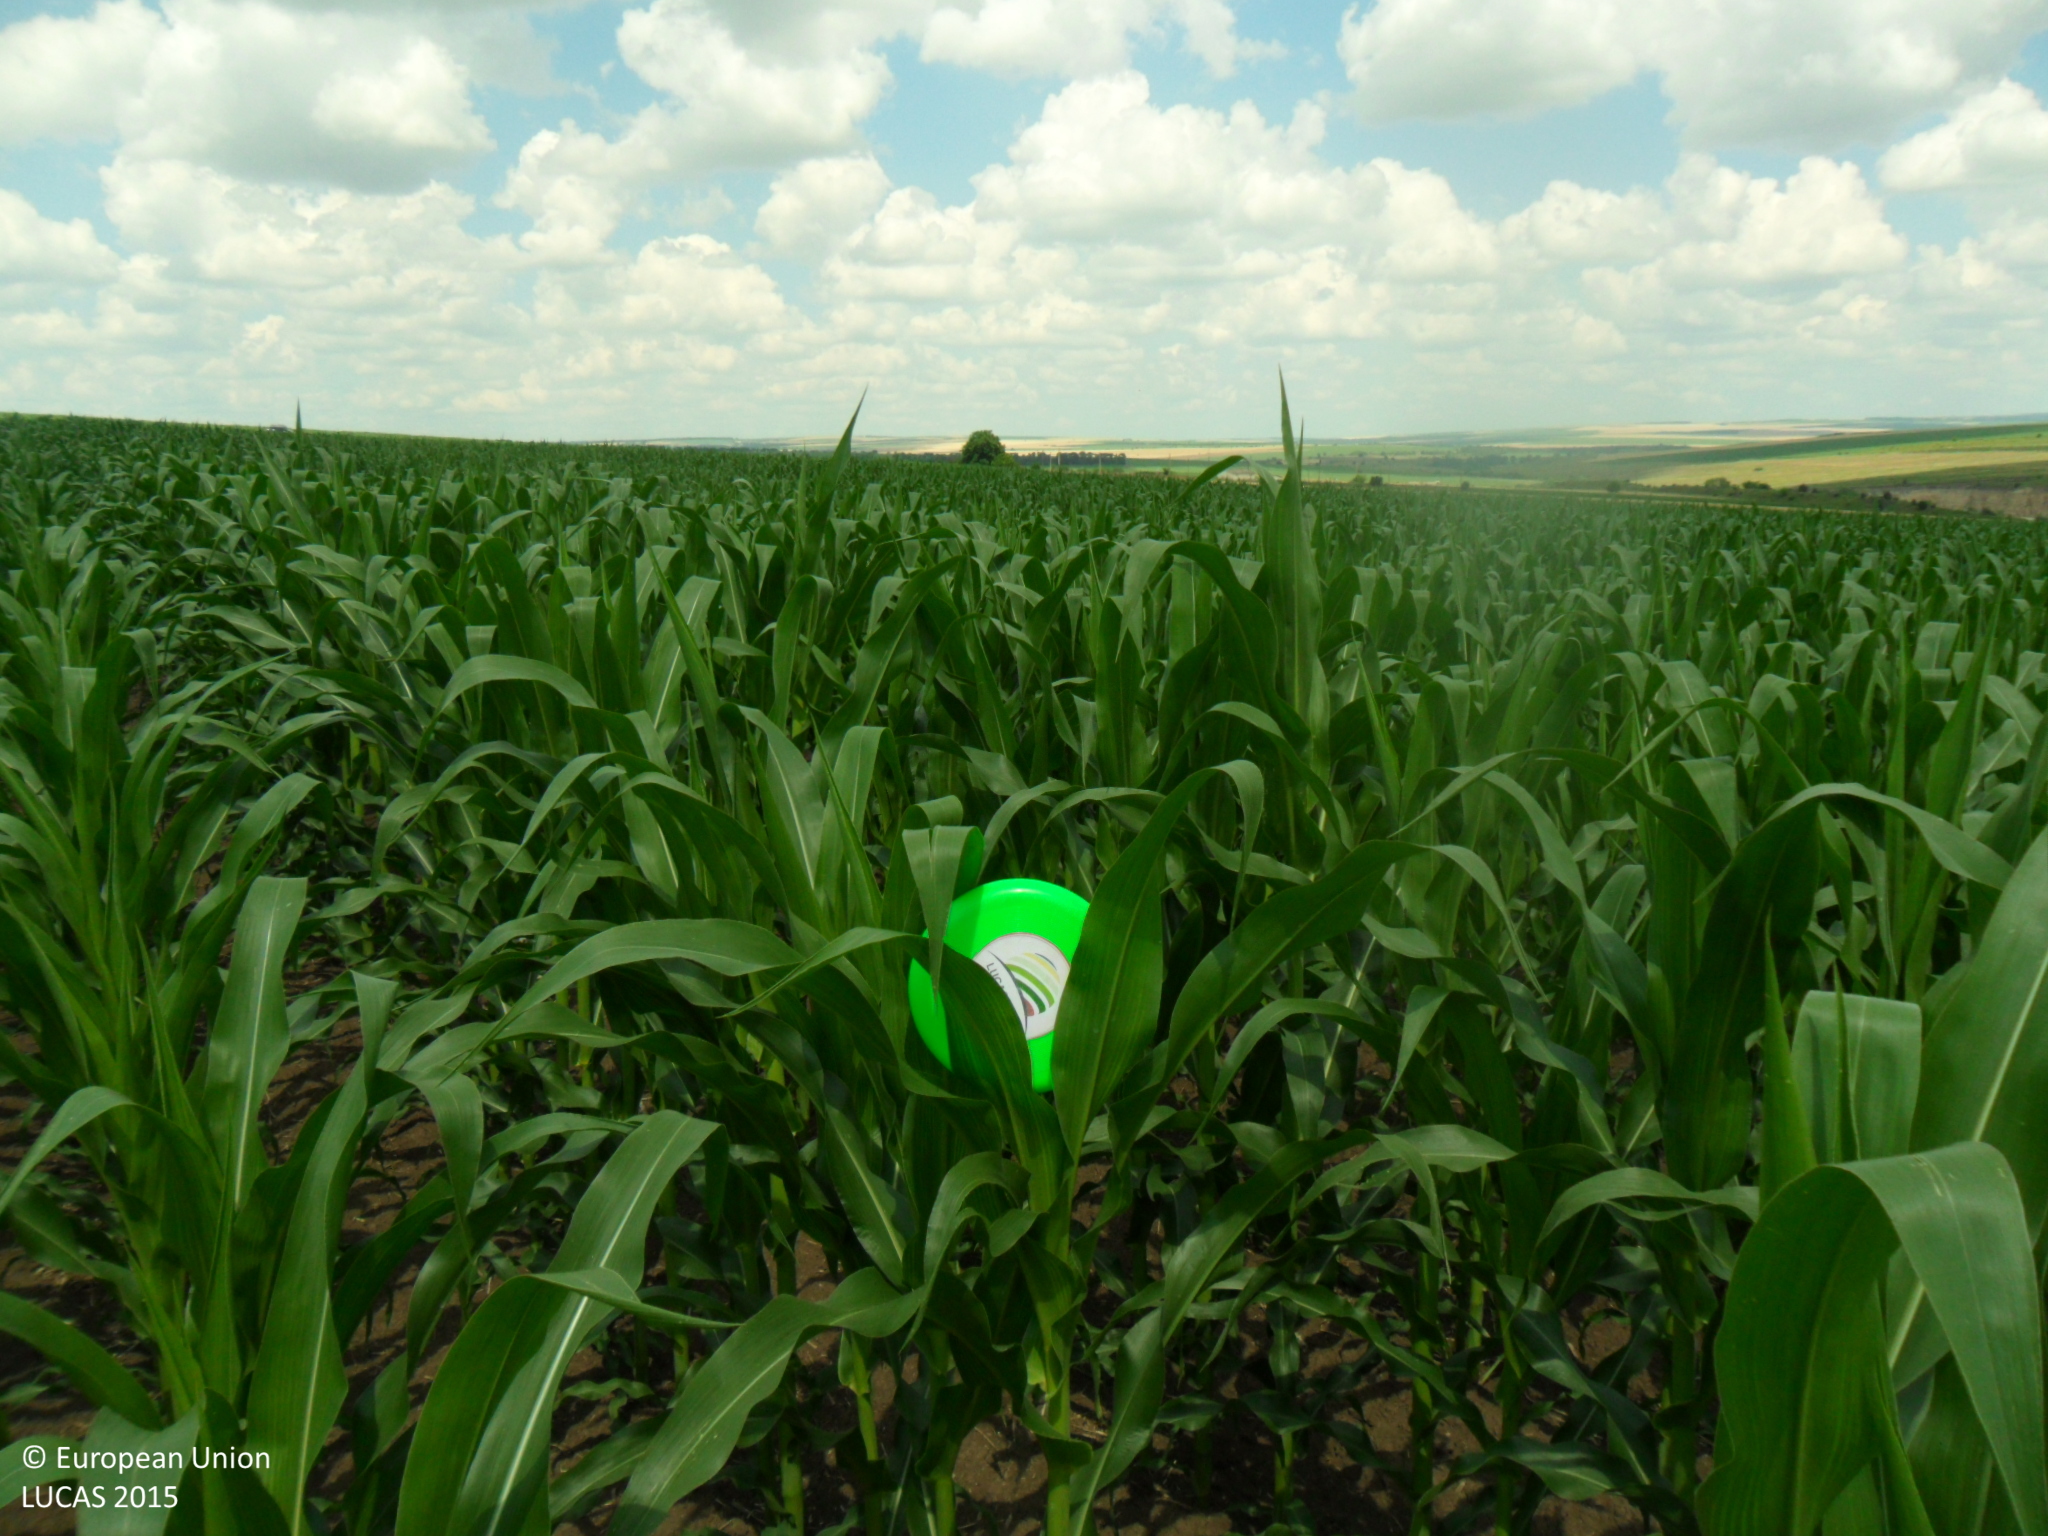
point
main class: Cropland
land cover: Maize
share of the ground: > 75 %
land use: Agriculture (excluding fallow land and kitchen gardens)
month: June
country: BG
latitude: 43.3491
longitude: 27.0555
